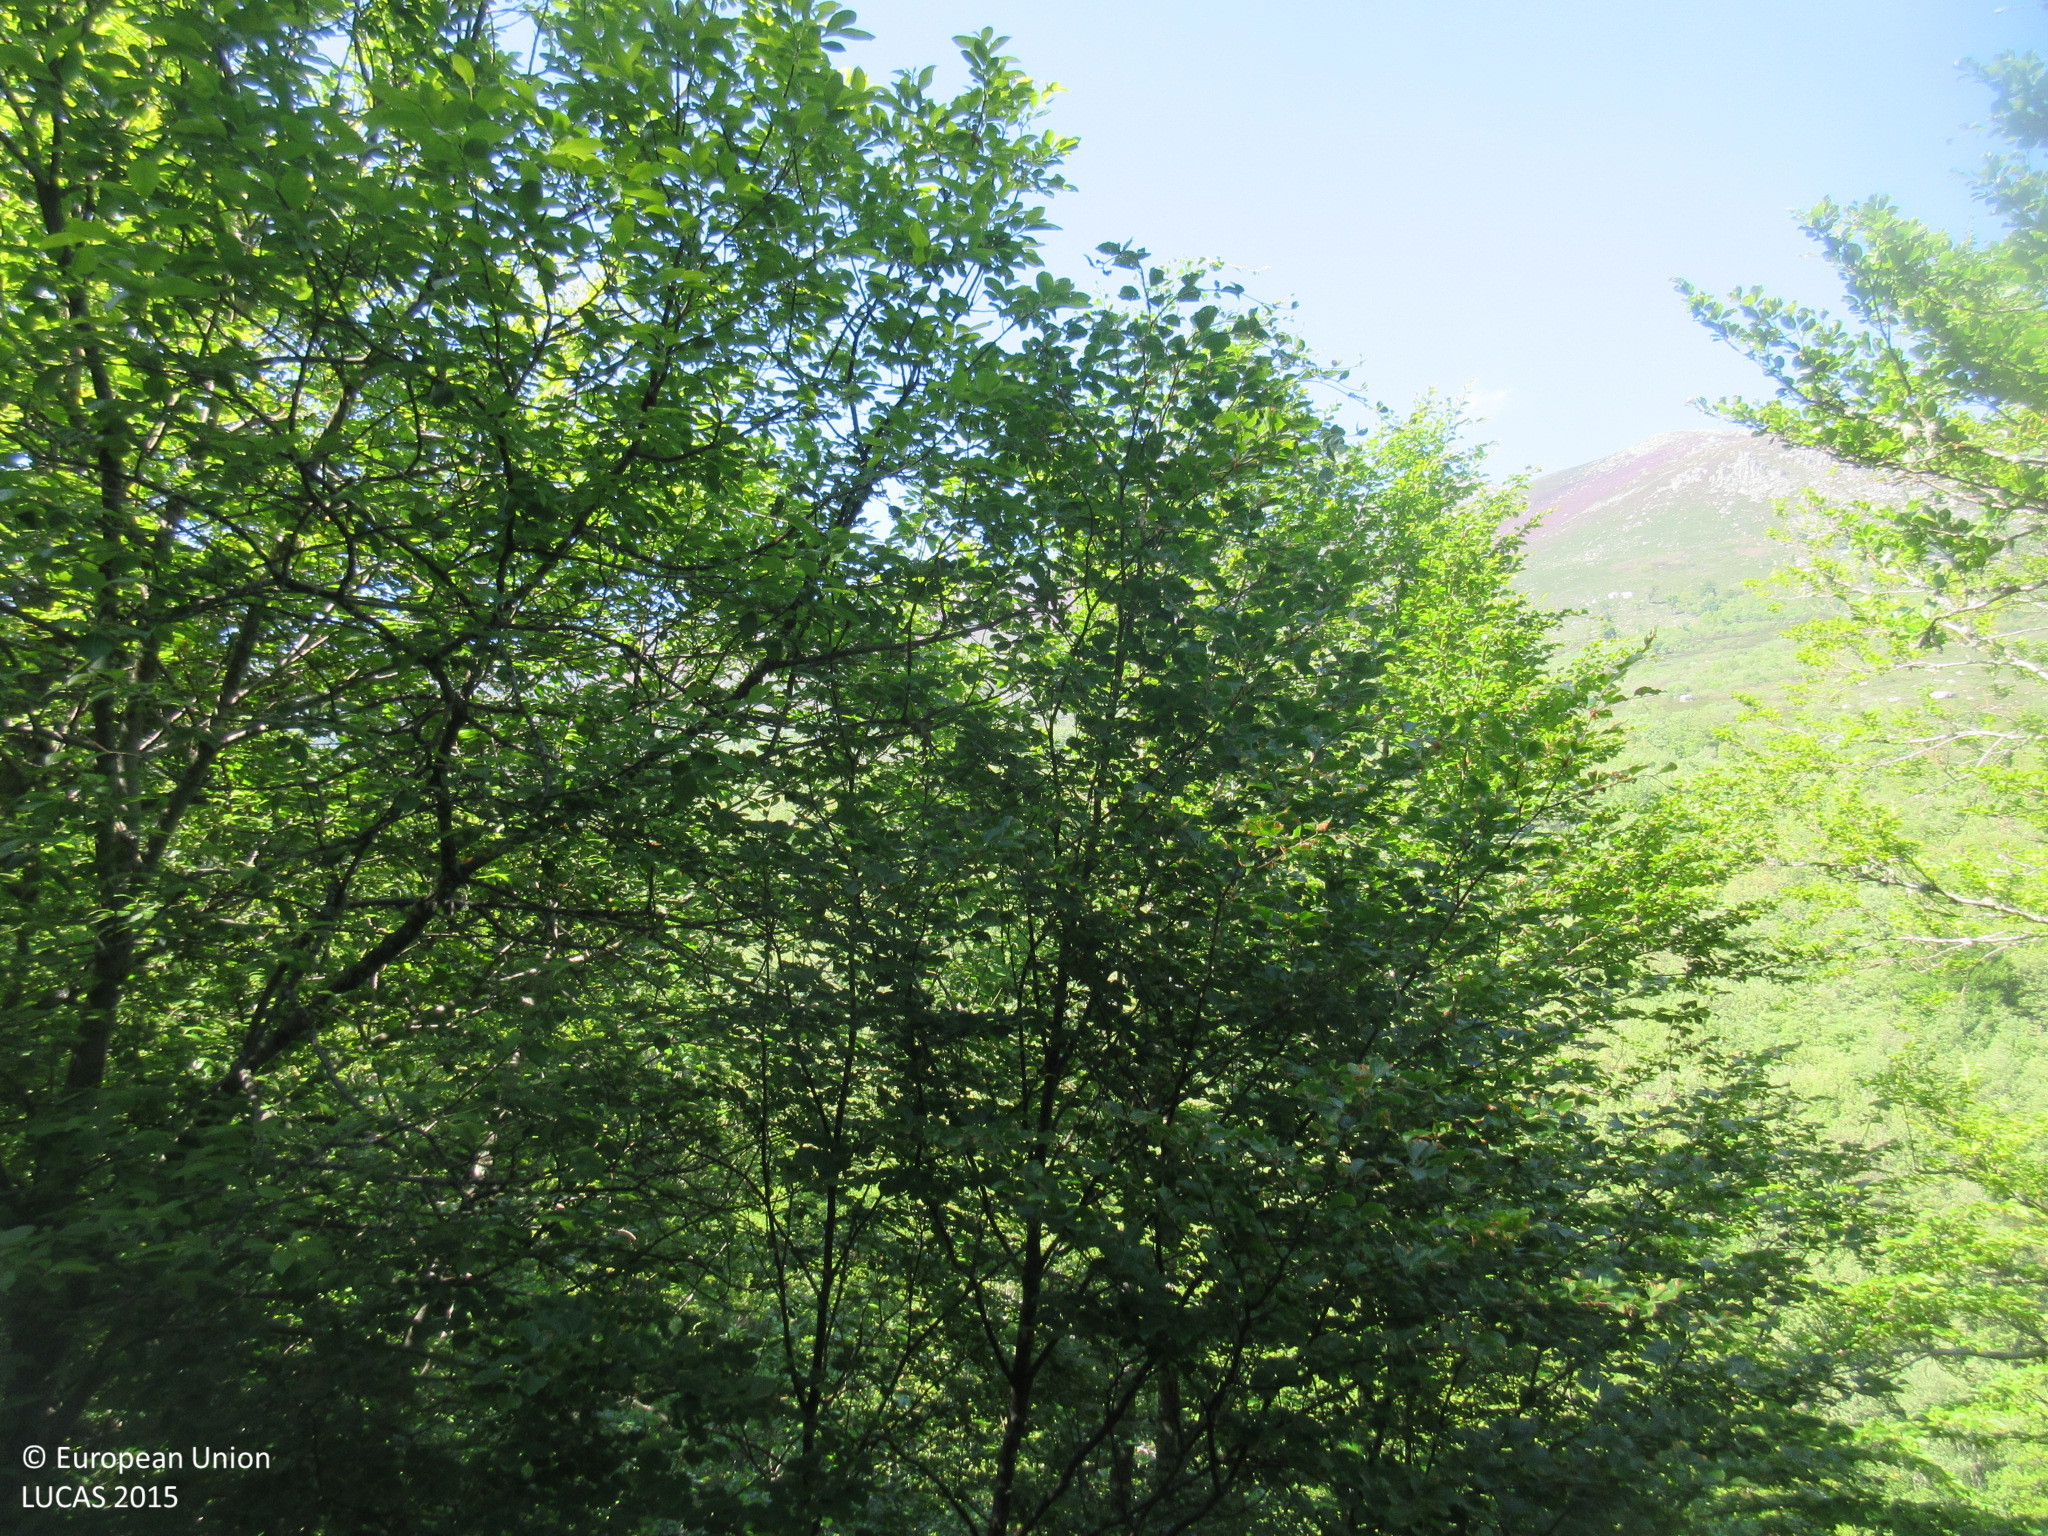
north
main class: Woodland
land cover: Broadleaved woodland
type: beech forest
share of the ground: > 75 %
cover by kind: broadleaved forest trees 100 %
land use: Semi-natural and natural areas not in use
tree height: > 5 m
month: June
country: ES
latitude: 43.1136
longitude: -4.4476
